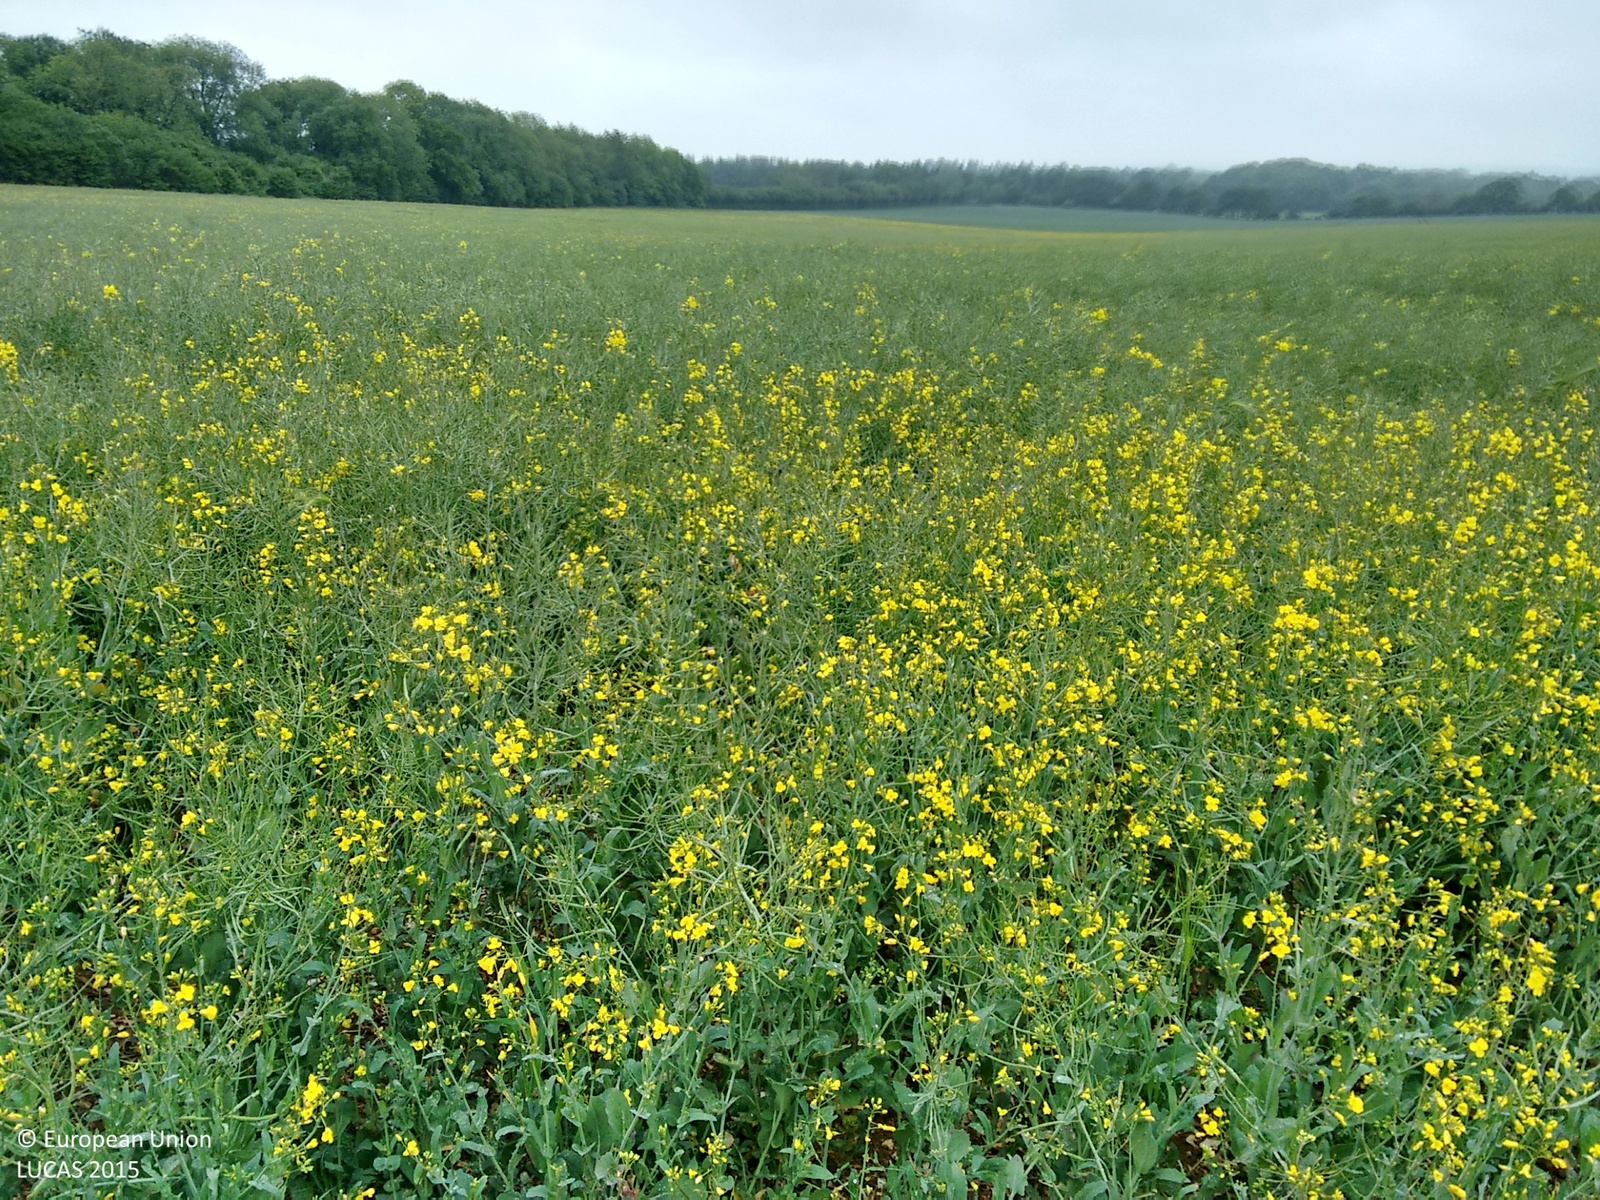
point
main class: Cropland
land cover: Rape and turnip rape
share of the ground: > 75 %
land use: Agriculture (excluding fallow land and kitchen gardens)
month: June
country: GB
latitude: 51.1271
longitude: -1.1199
